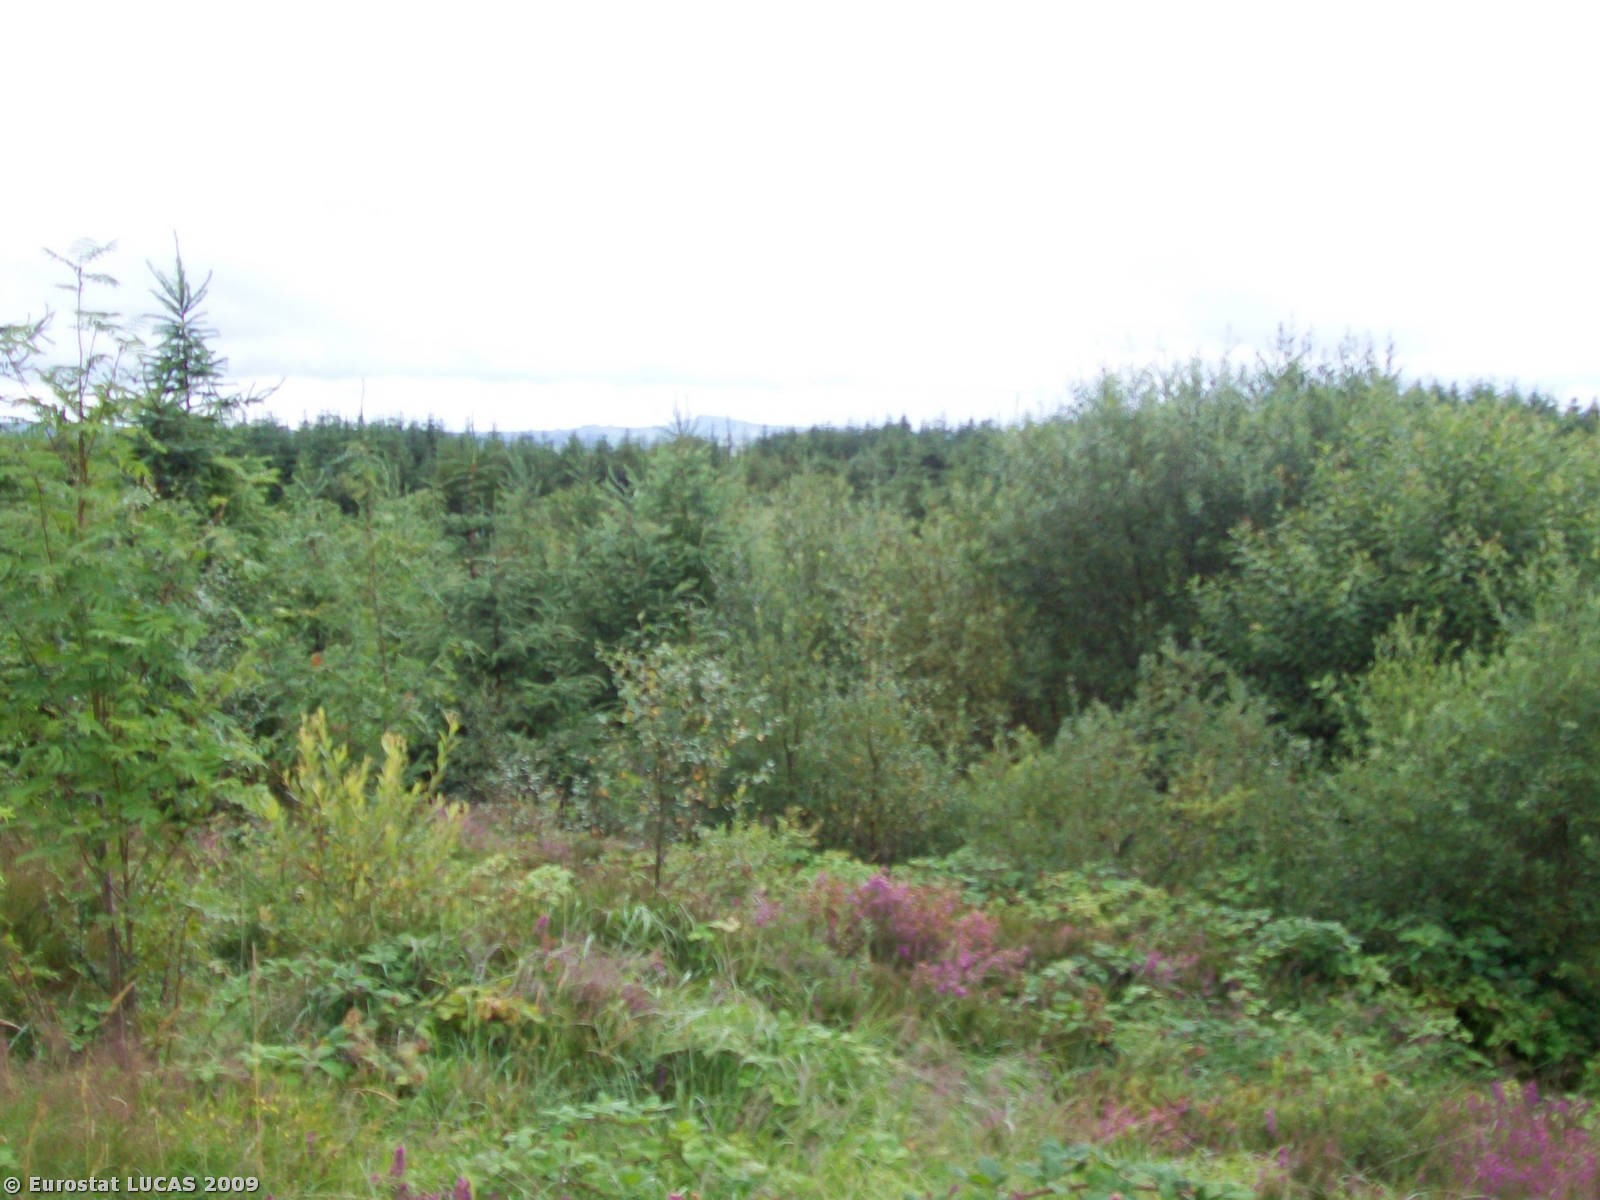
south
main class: Woodland
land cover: Coniferous woodland
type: plantations and self-sown exotic forest
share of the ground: > 75 %
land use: Forestry
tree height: > 5 m
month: July
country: IE
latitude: 53.9580
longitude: -9.0665
